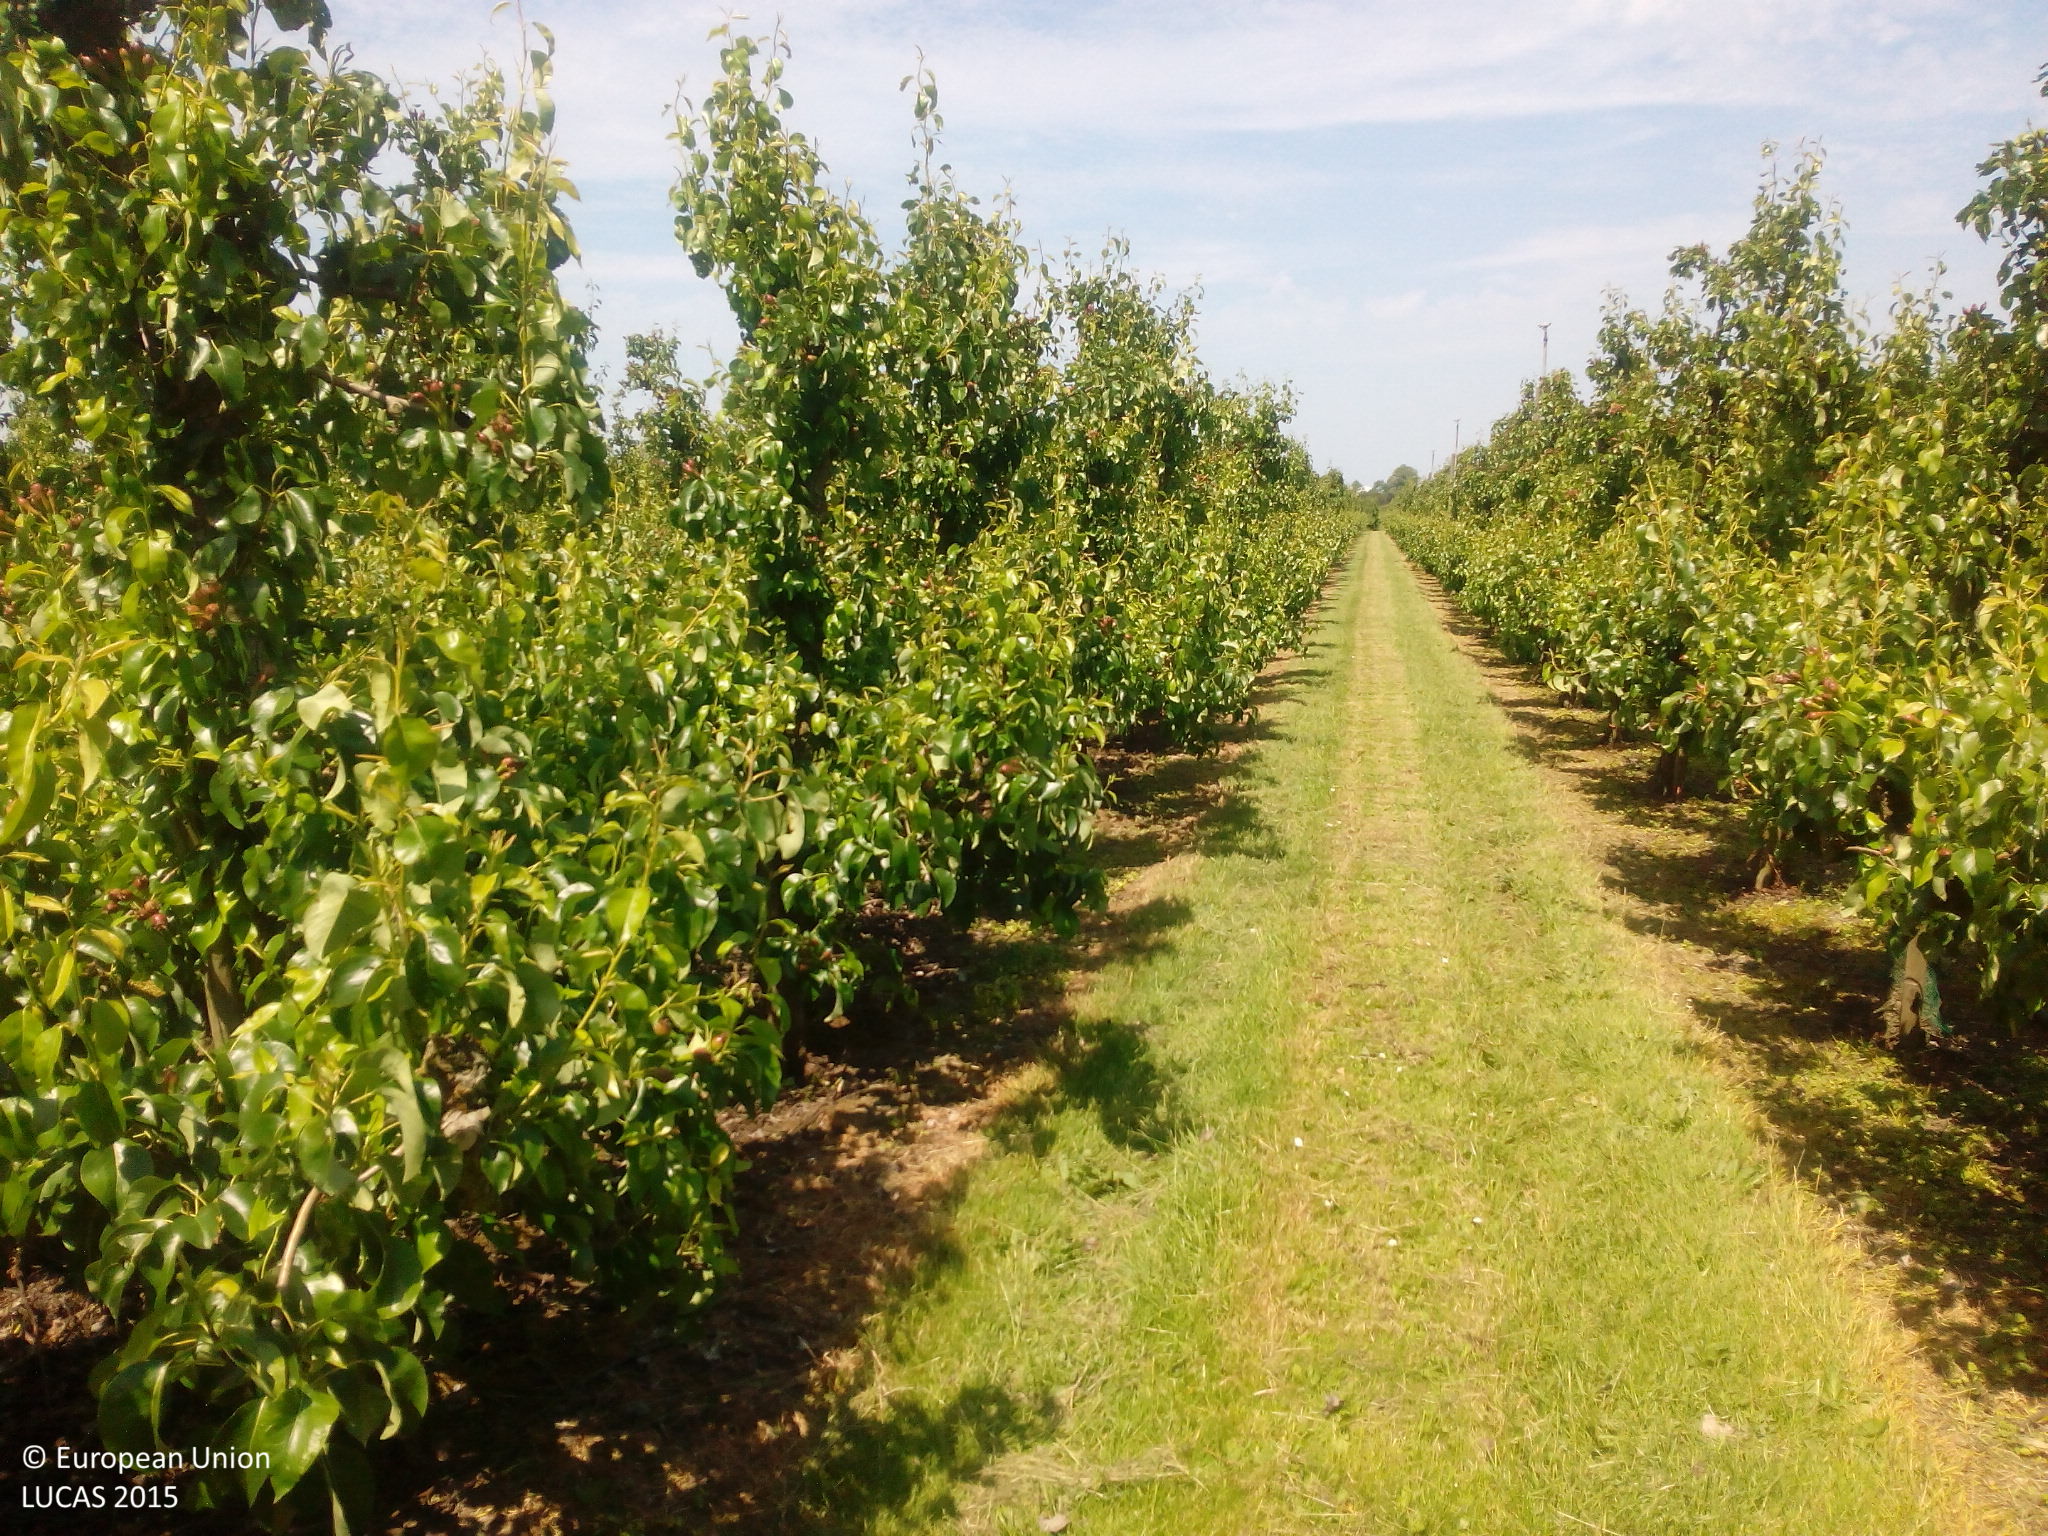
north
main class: Cropland
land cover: Pear fruit
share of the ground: > 75 %
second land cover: Grassland without tree/shrub cover
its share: > 75 %
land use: Agriculture (excluding fallow land and kitchen gardens)
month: June
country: NL
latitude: 51.4203
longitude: 4.1130
